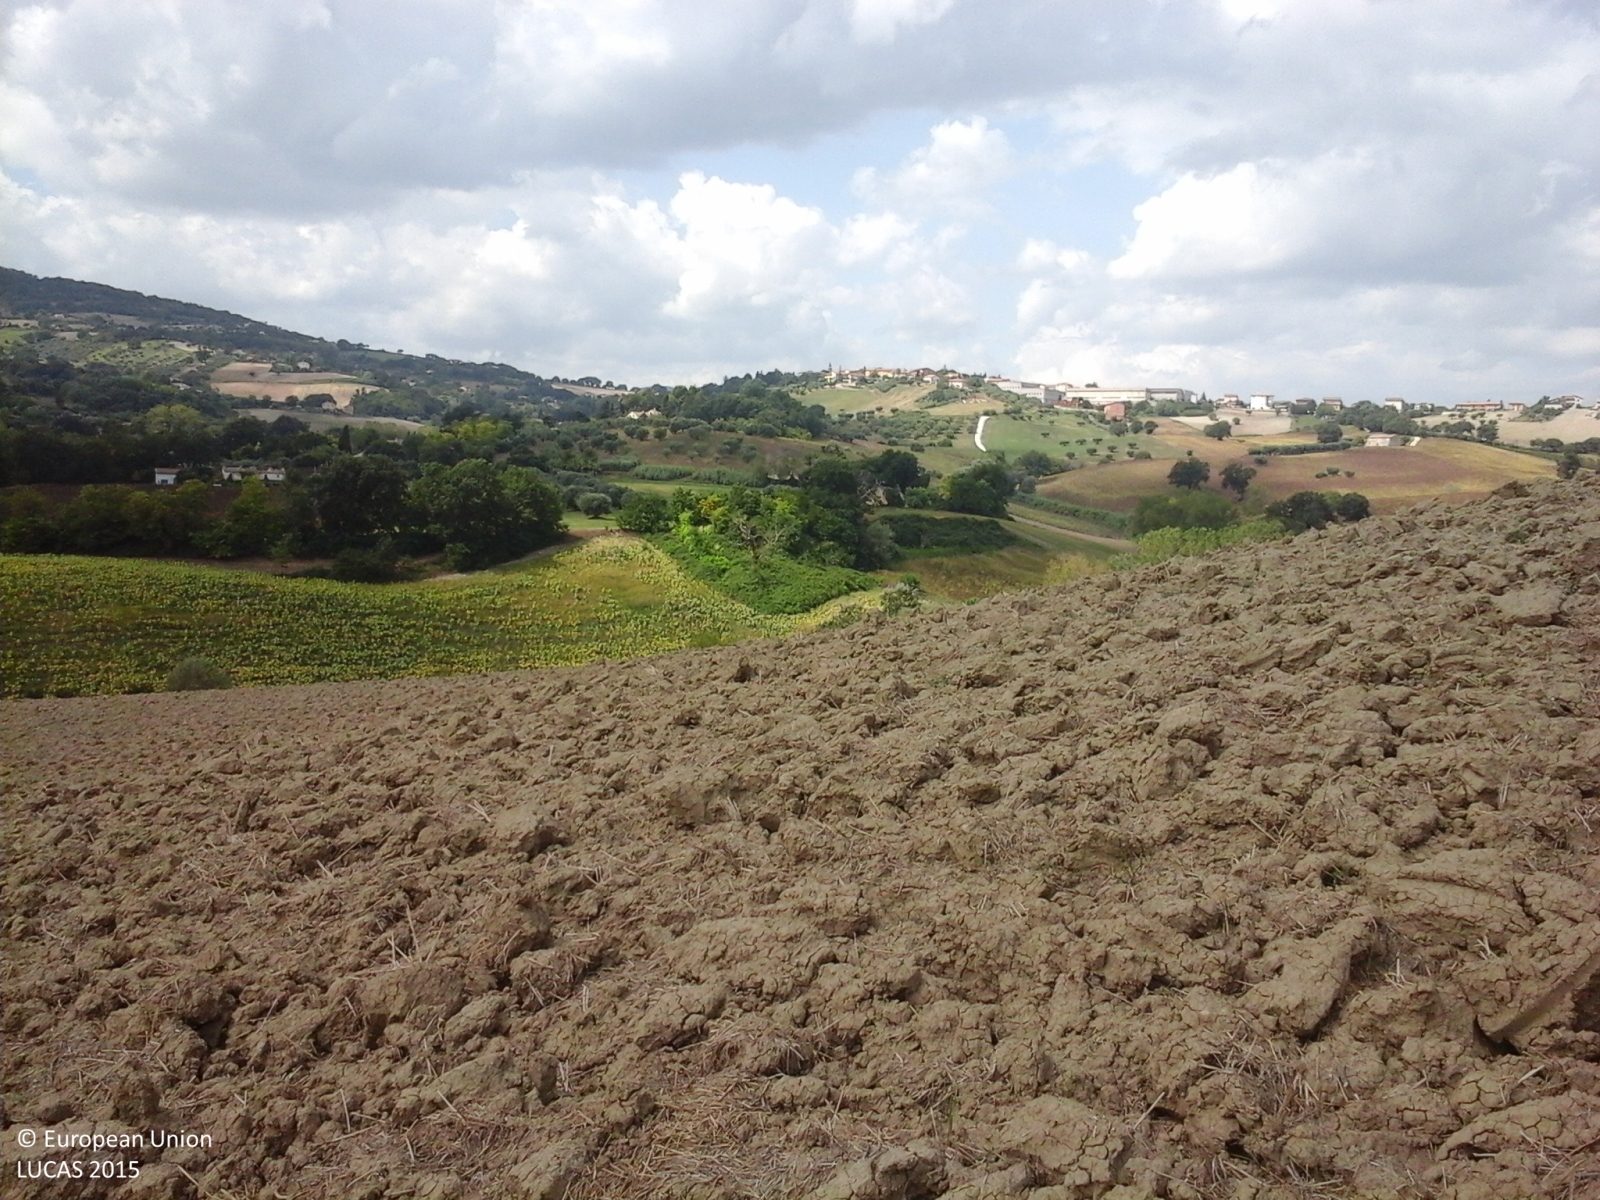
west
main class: Cropland
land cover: Durum wheat
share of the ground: < 10 %
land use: Agriculture (excluding fallow land and kitchen gardens)
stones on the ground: 10 - 25 %
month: August
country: IT
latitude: 43.3972
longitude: 13.2389
